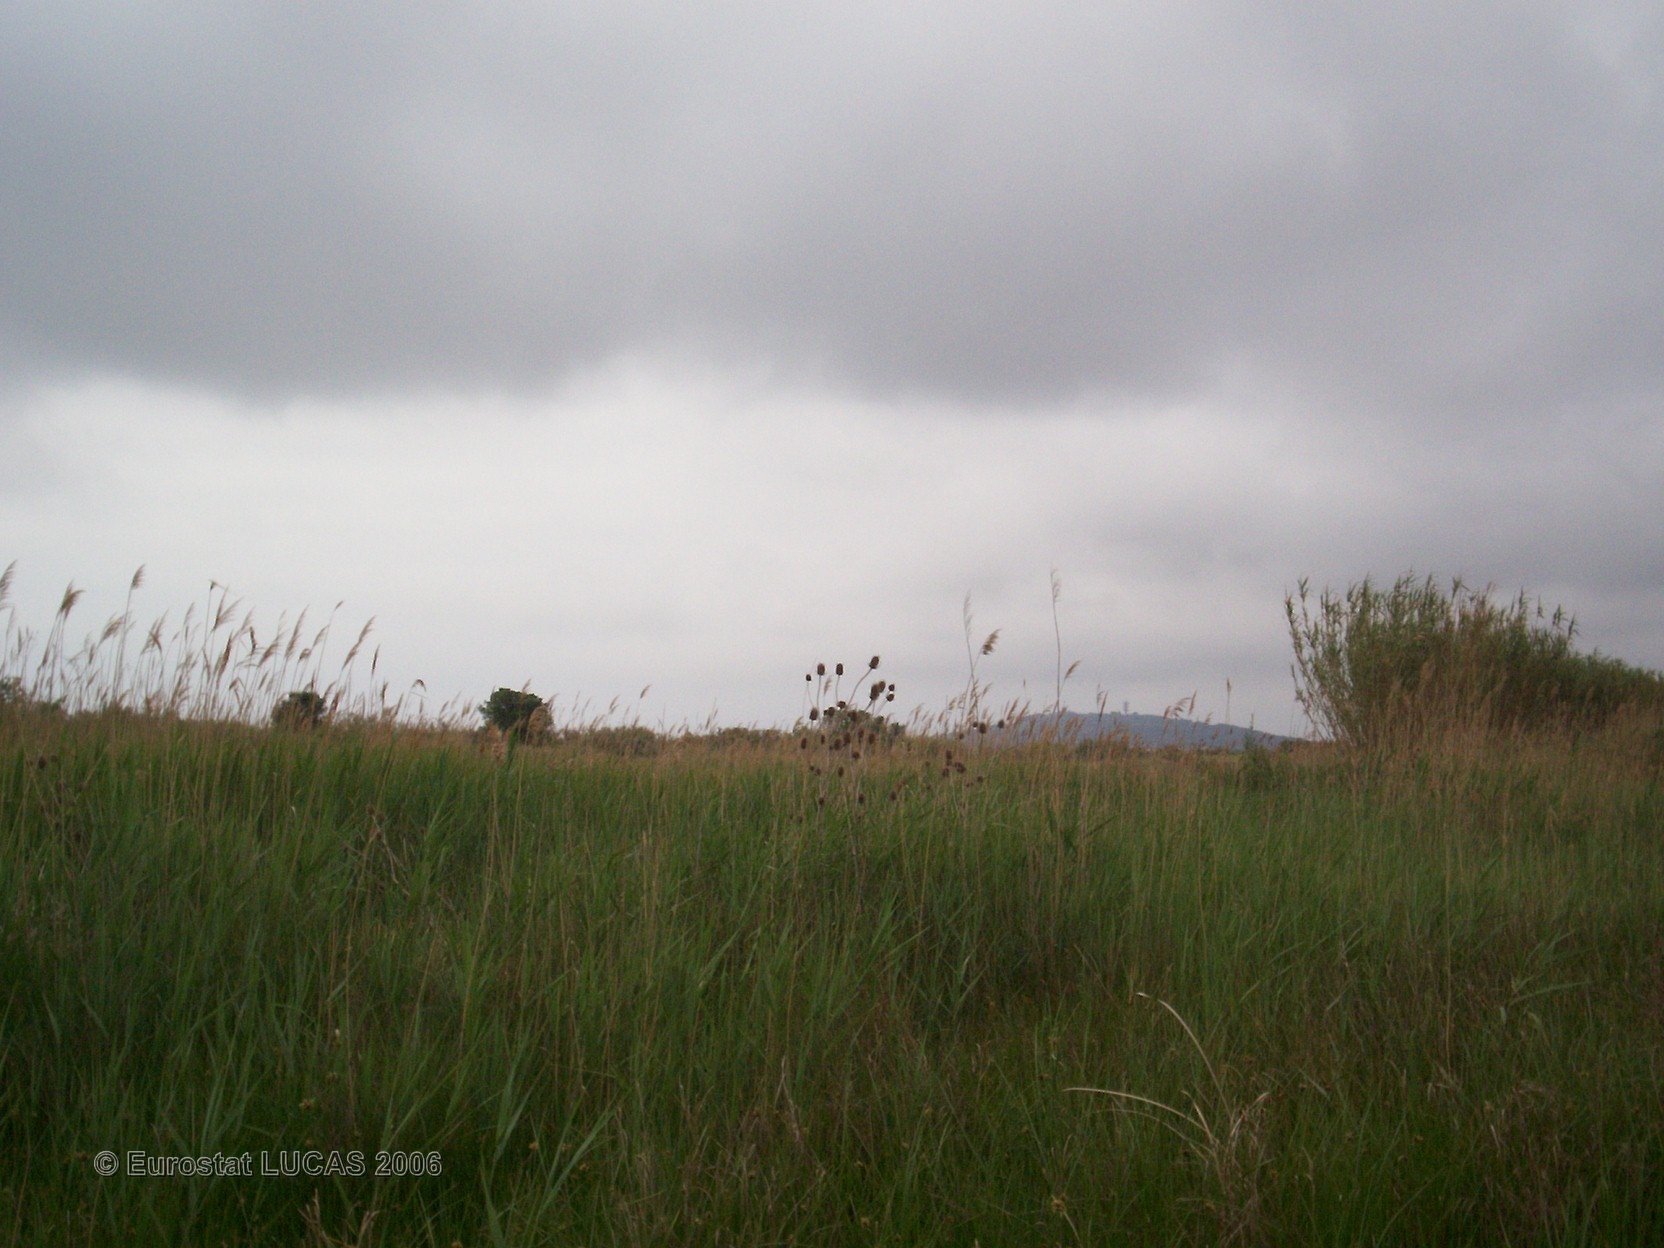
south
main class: Grassland
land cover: Grassland without tree/shrub cover
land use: Unused
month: May
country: FR
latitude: 43.3330
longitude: 3.5101
